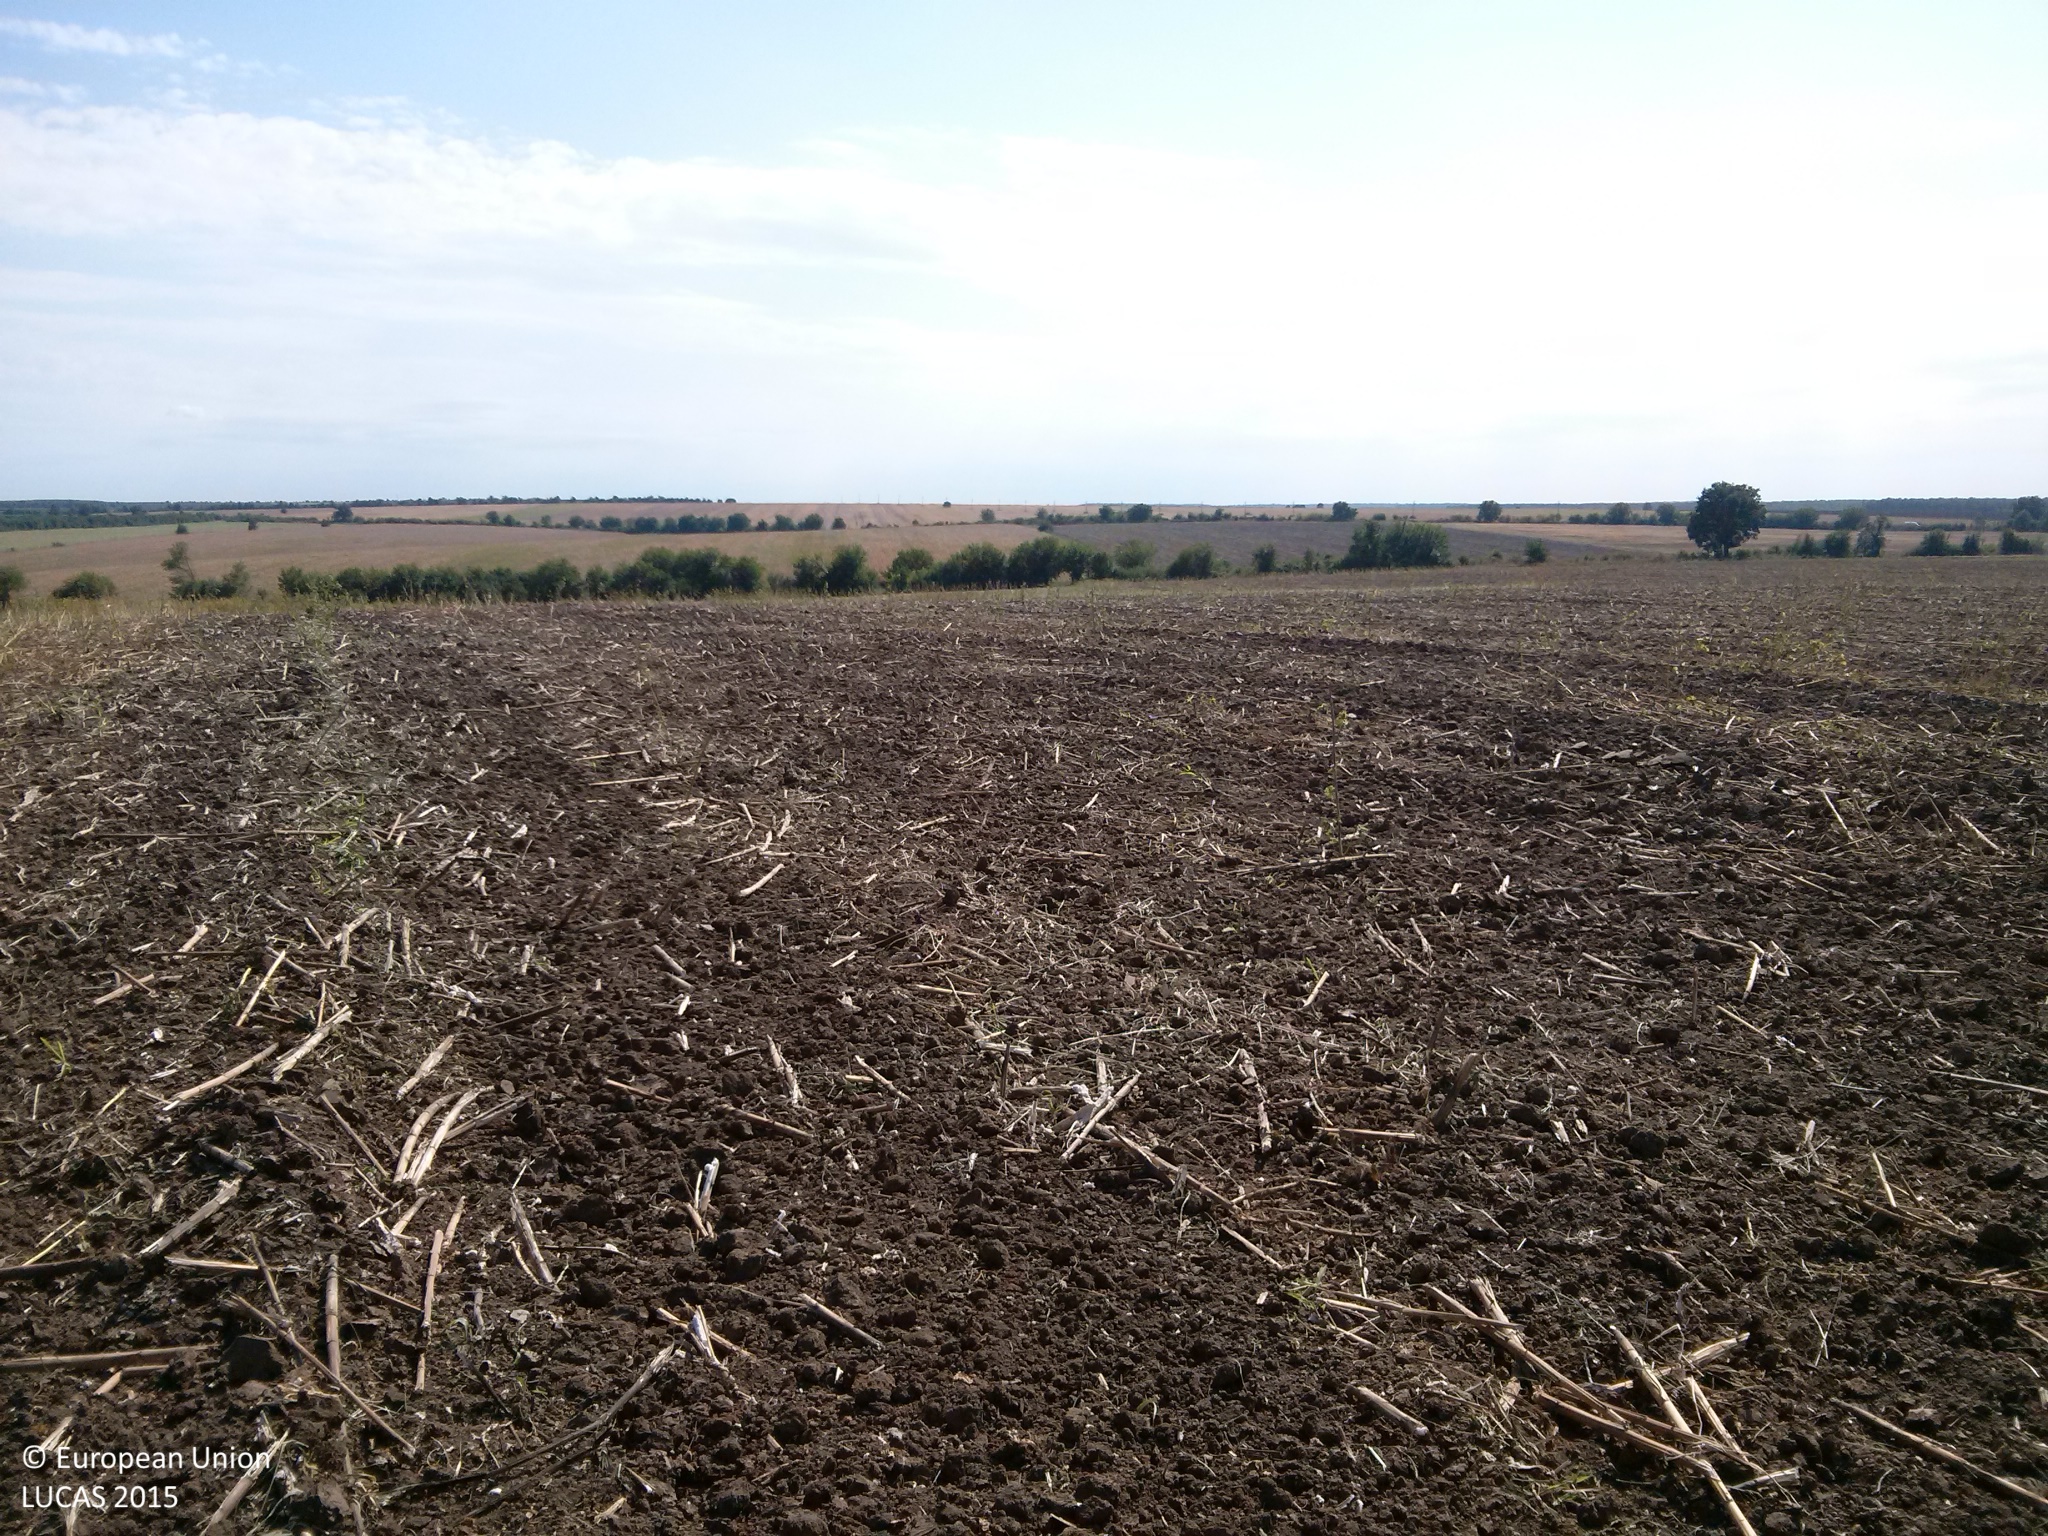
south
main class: Cropland
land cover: Sunflower
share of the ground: 10 - 25 %
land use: Agriculture (excluding fallow land and kitchen gardens)
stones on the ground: < 10 %
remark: Harvested field
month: September
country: BG
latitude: 43.8630
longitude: 26.3931
